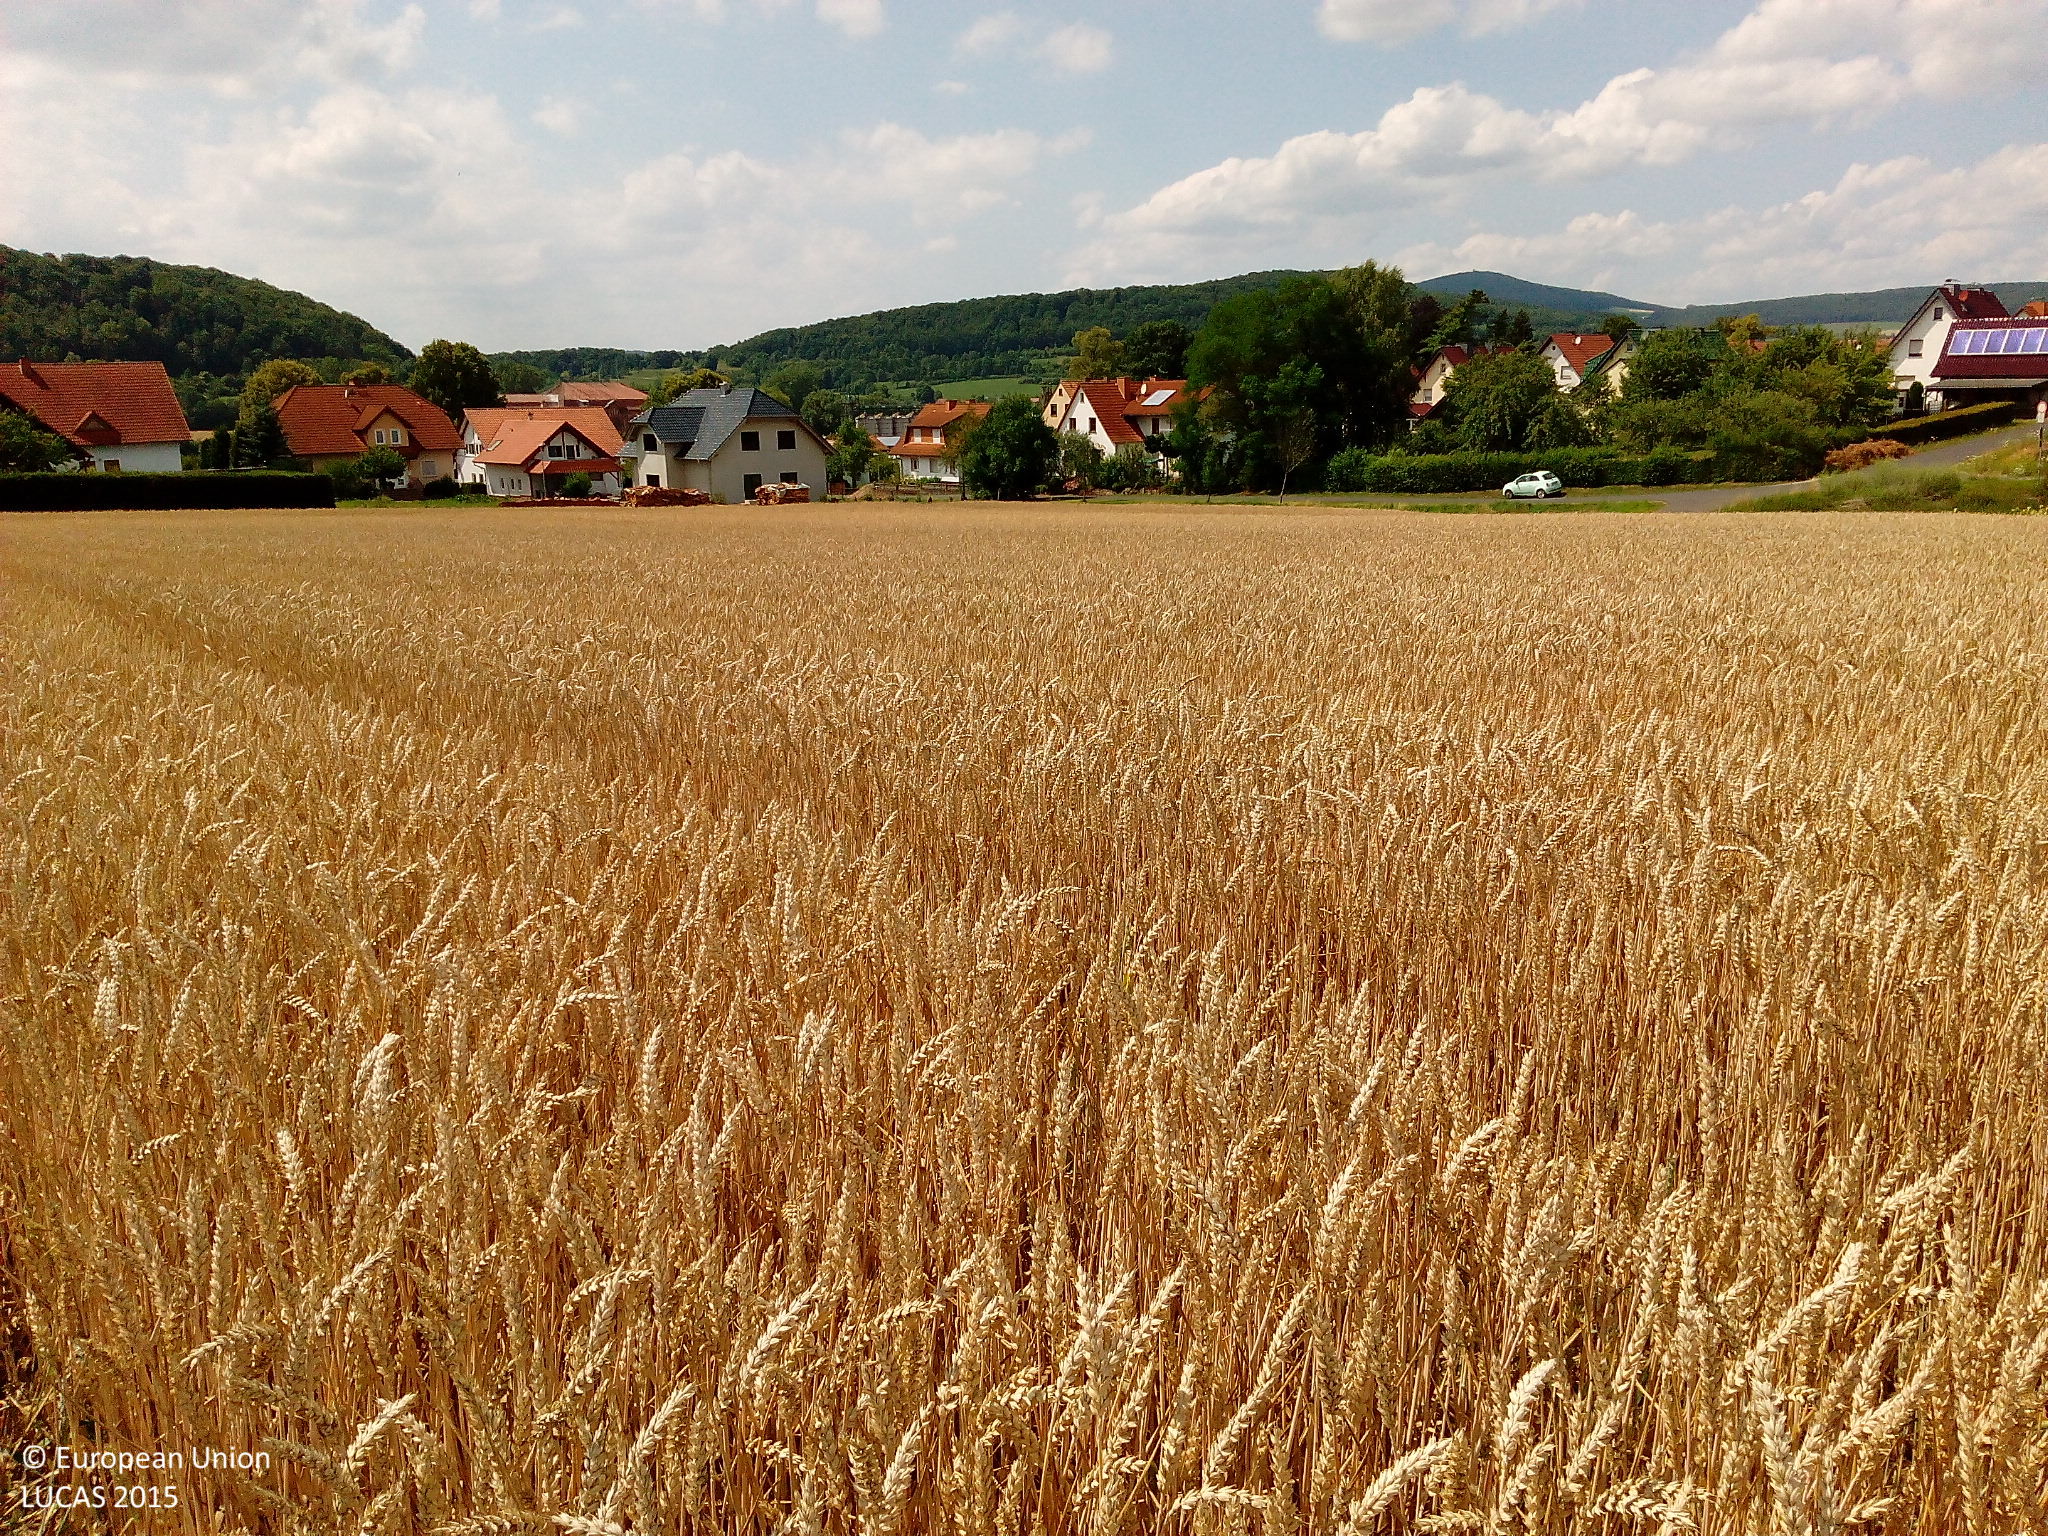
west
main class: Cropland
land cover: Common wheat
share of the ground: > 75 %
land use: Agriculture (excluding fallow land and kitchen gardens)
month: July
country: DE
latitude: 50.7596
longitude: 9.9575
